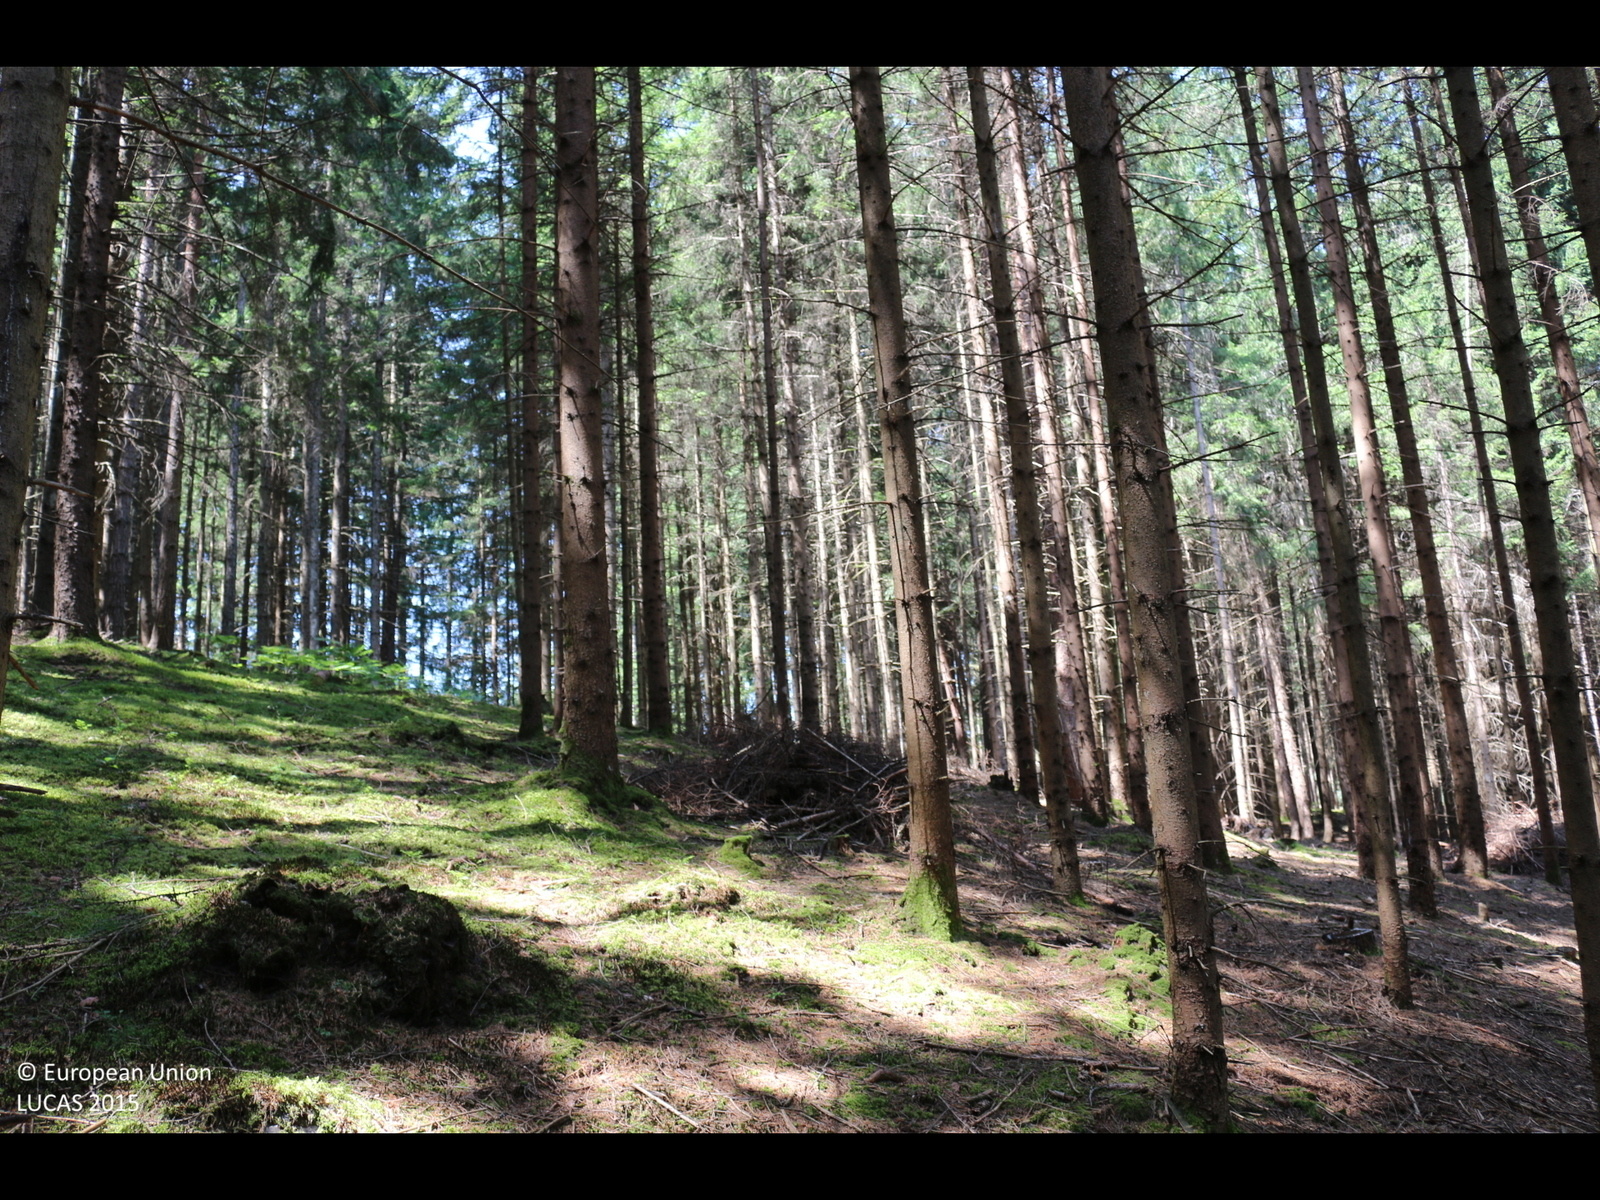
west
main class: Woodland
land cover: Spruce dominated coniferous woodland
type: alpine coniferous forest
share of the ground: > 75 %
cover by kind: coniferous forest trees 100 %
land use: Forestry
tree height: > 5 m
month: July
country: AT
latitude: 46.7235
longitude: 13.5954
